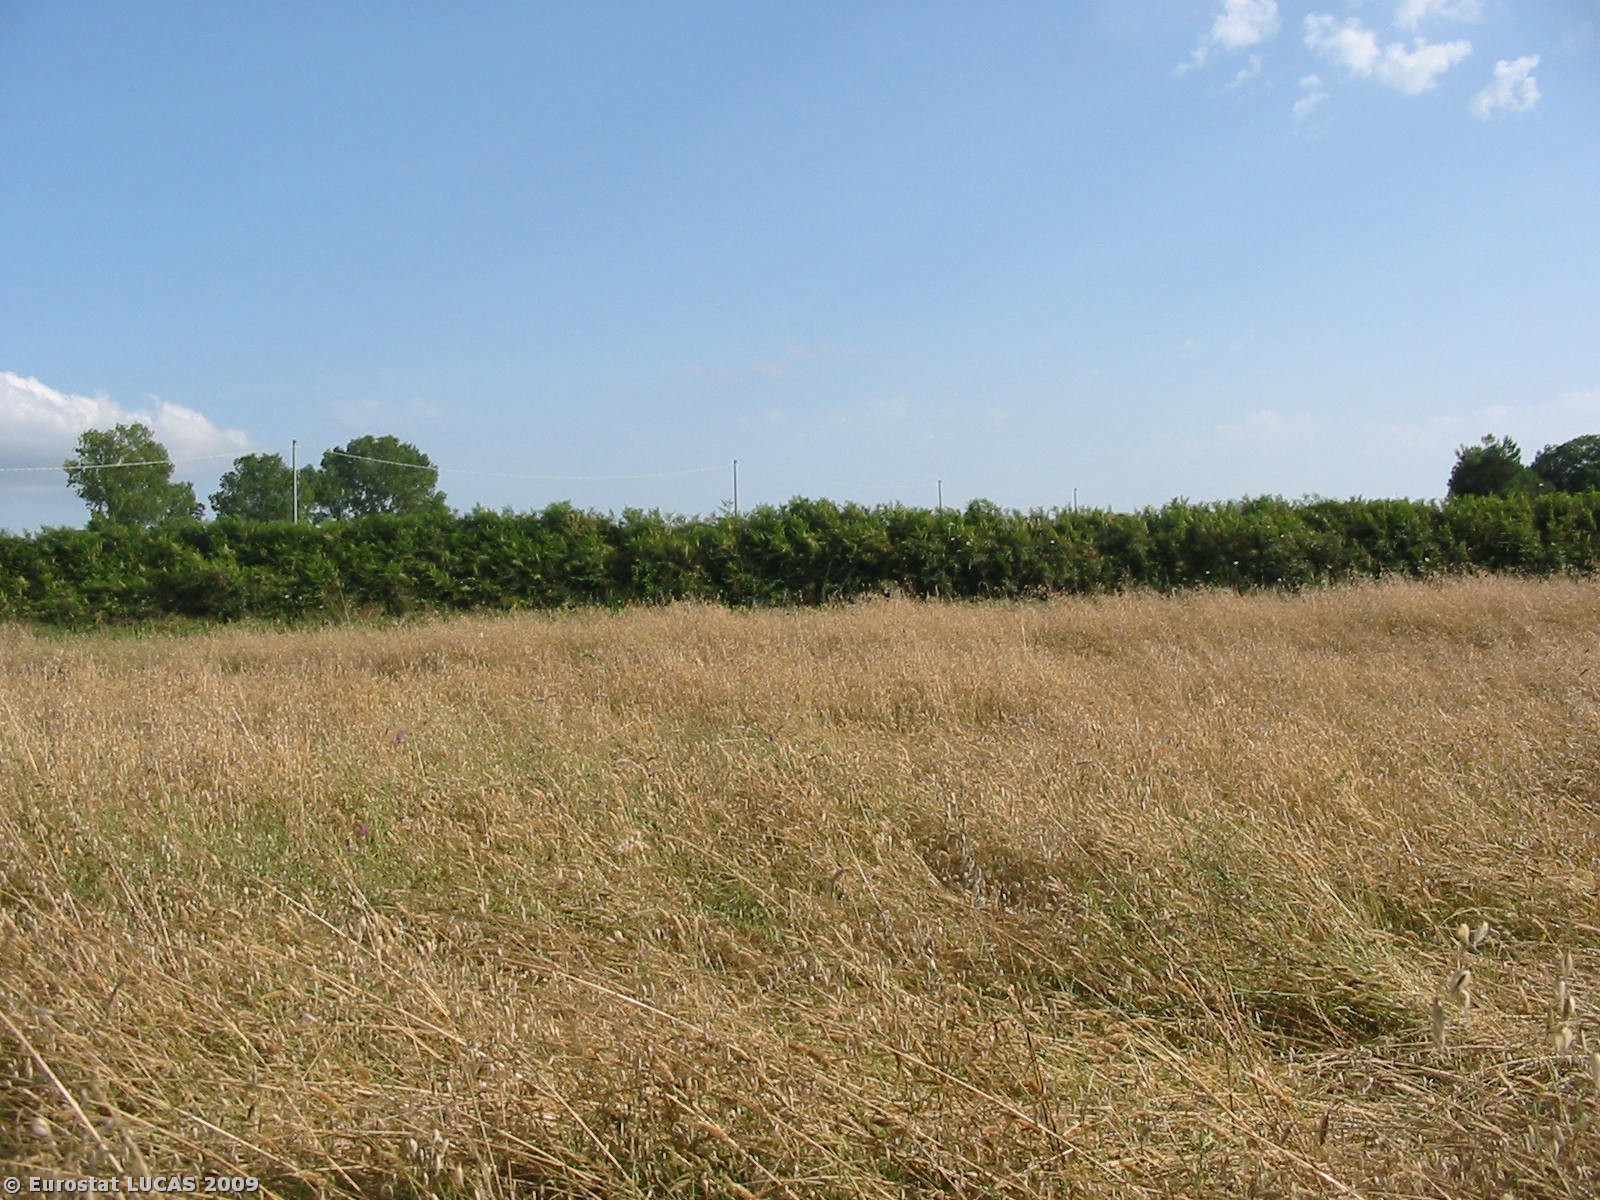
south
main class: Cropland
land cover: Oats
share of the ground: > 75 %
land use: Agriculture (excluding fallow land and kitchen gardens)
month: July
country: IT
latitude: 38.6144
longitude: 15.9724
